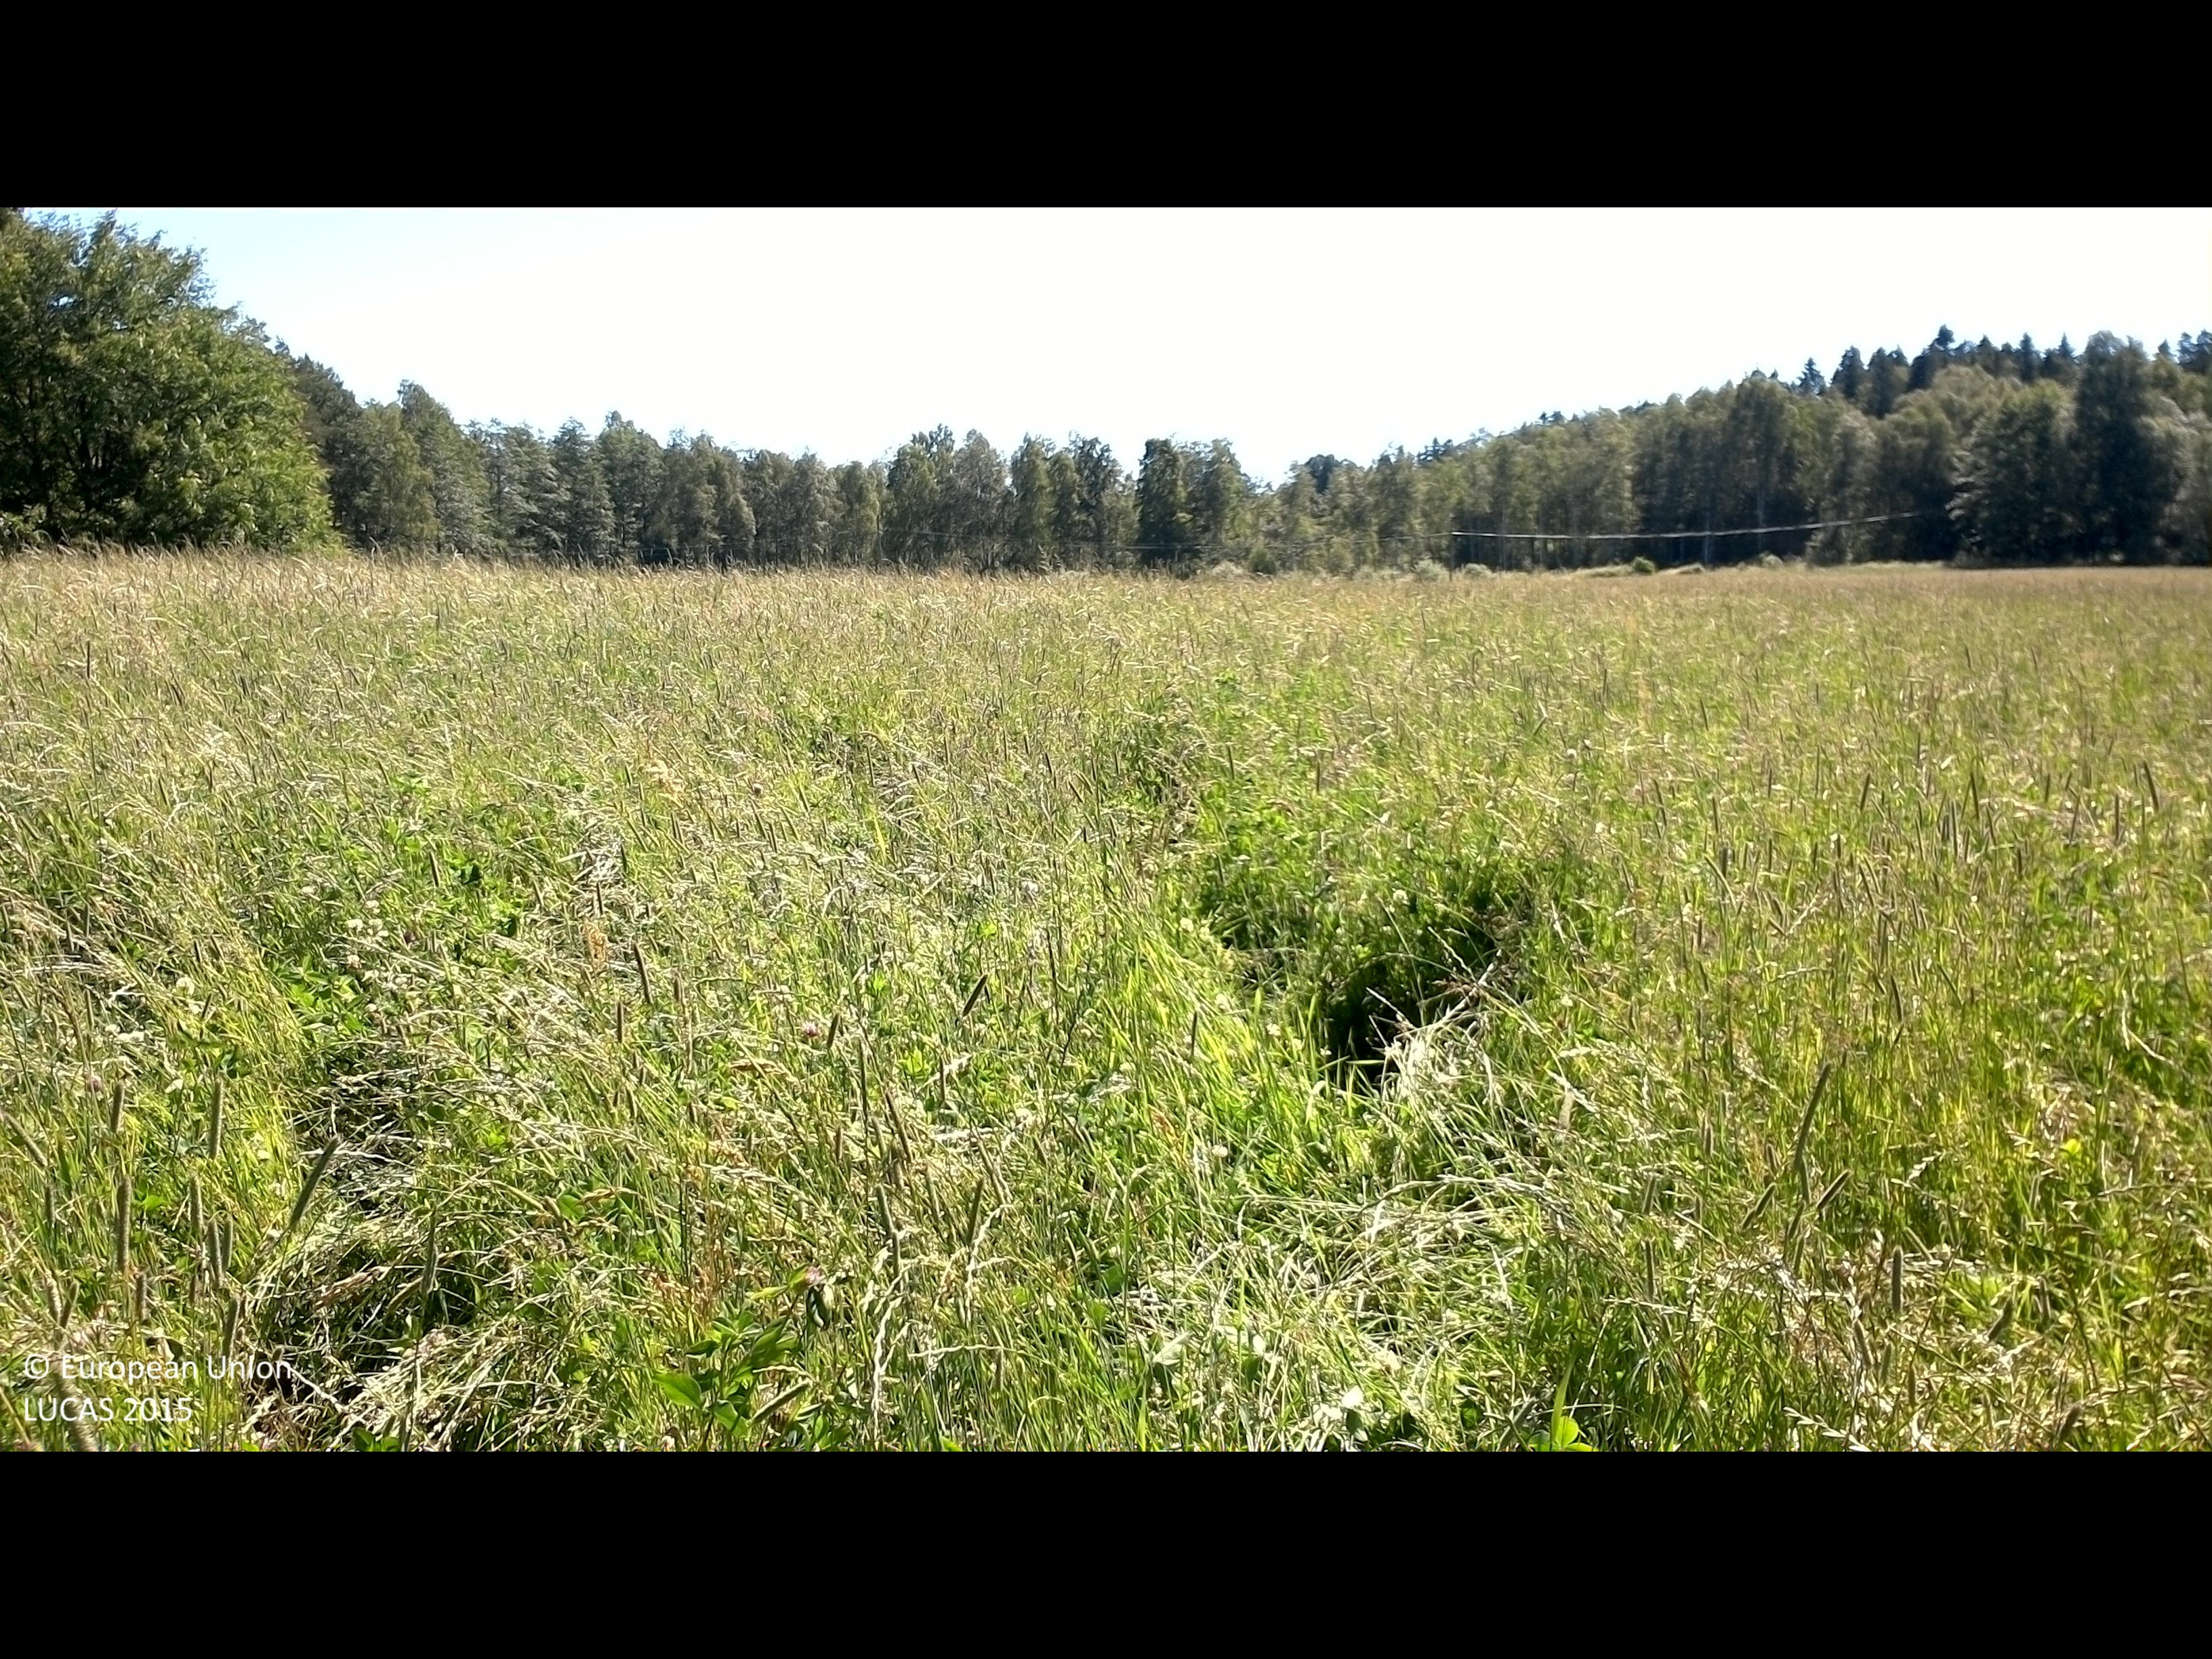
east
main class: Grassland
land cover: Grassland without tree/shrub cover
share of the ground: > 75 %
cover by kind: herbaceous plants 100 %
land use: Agriculture (excluding fallow land and kitchen gardens)
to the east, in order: Grassland without tree/shrub cover; Electric lines; Fences; Grass margins; Paved roads, cycling and walking lanes; Grass margins; Fences; Shrubland without tree cover; Broadleaved woodland
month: July
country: SE
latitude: 56.5114
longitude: 14.8241
